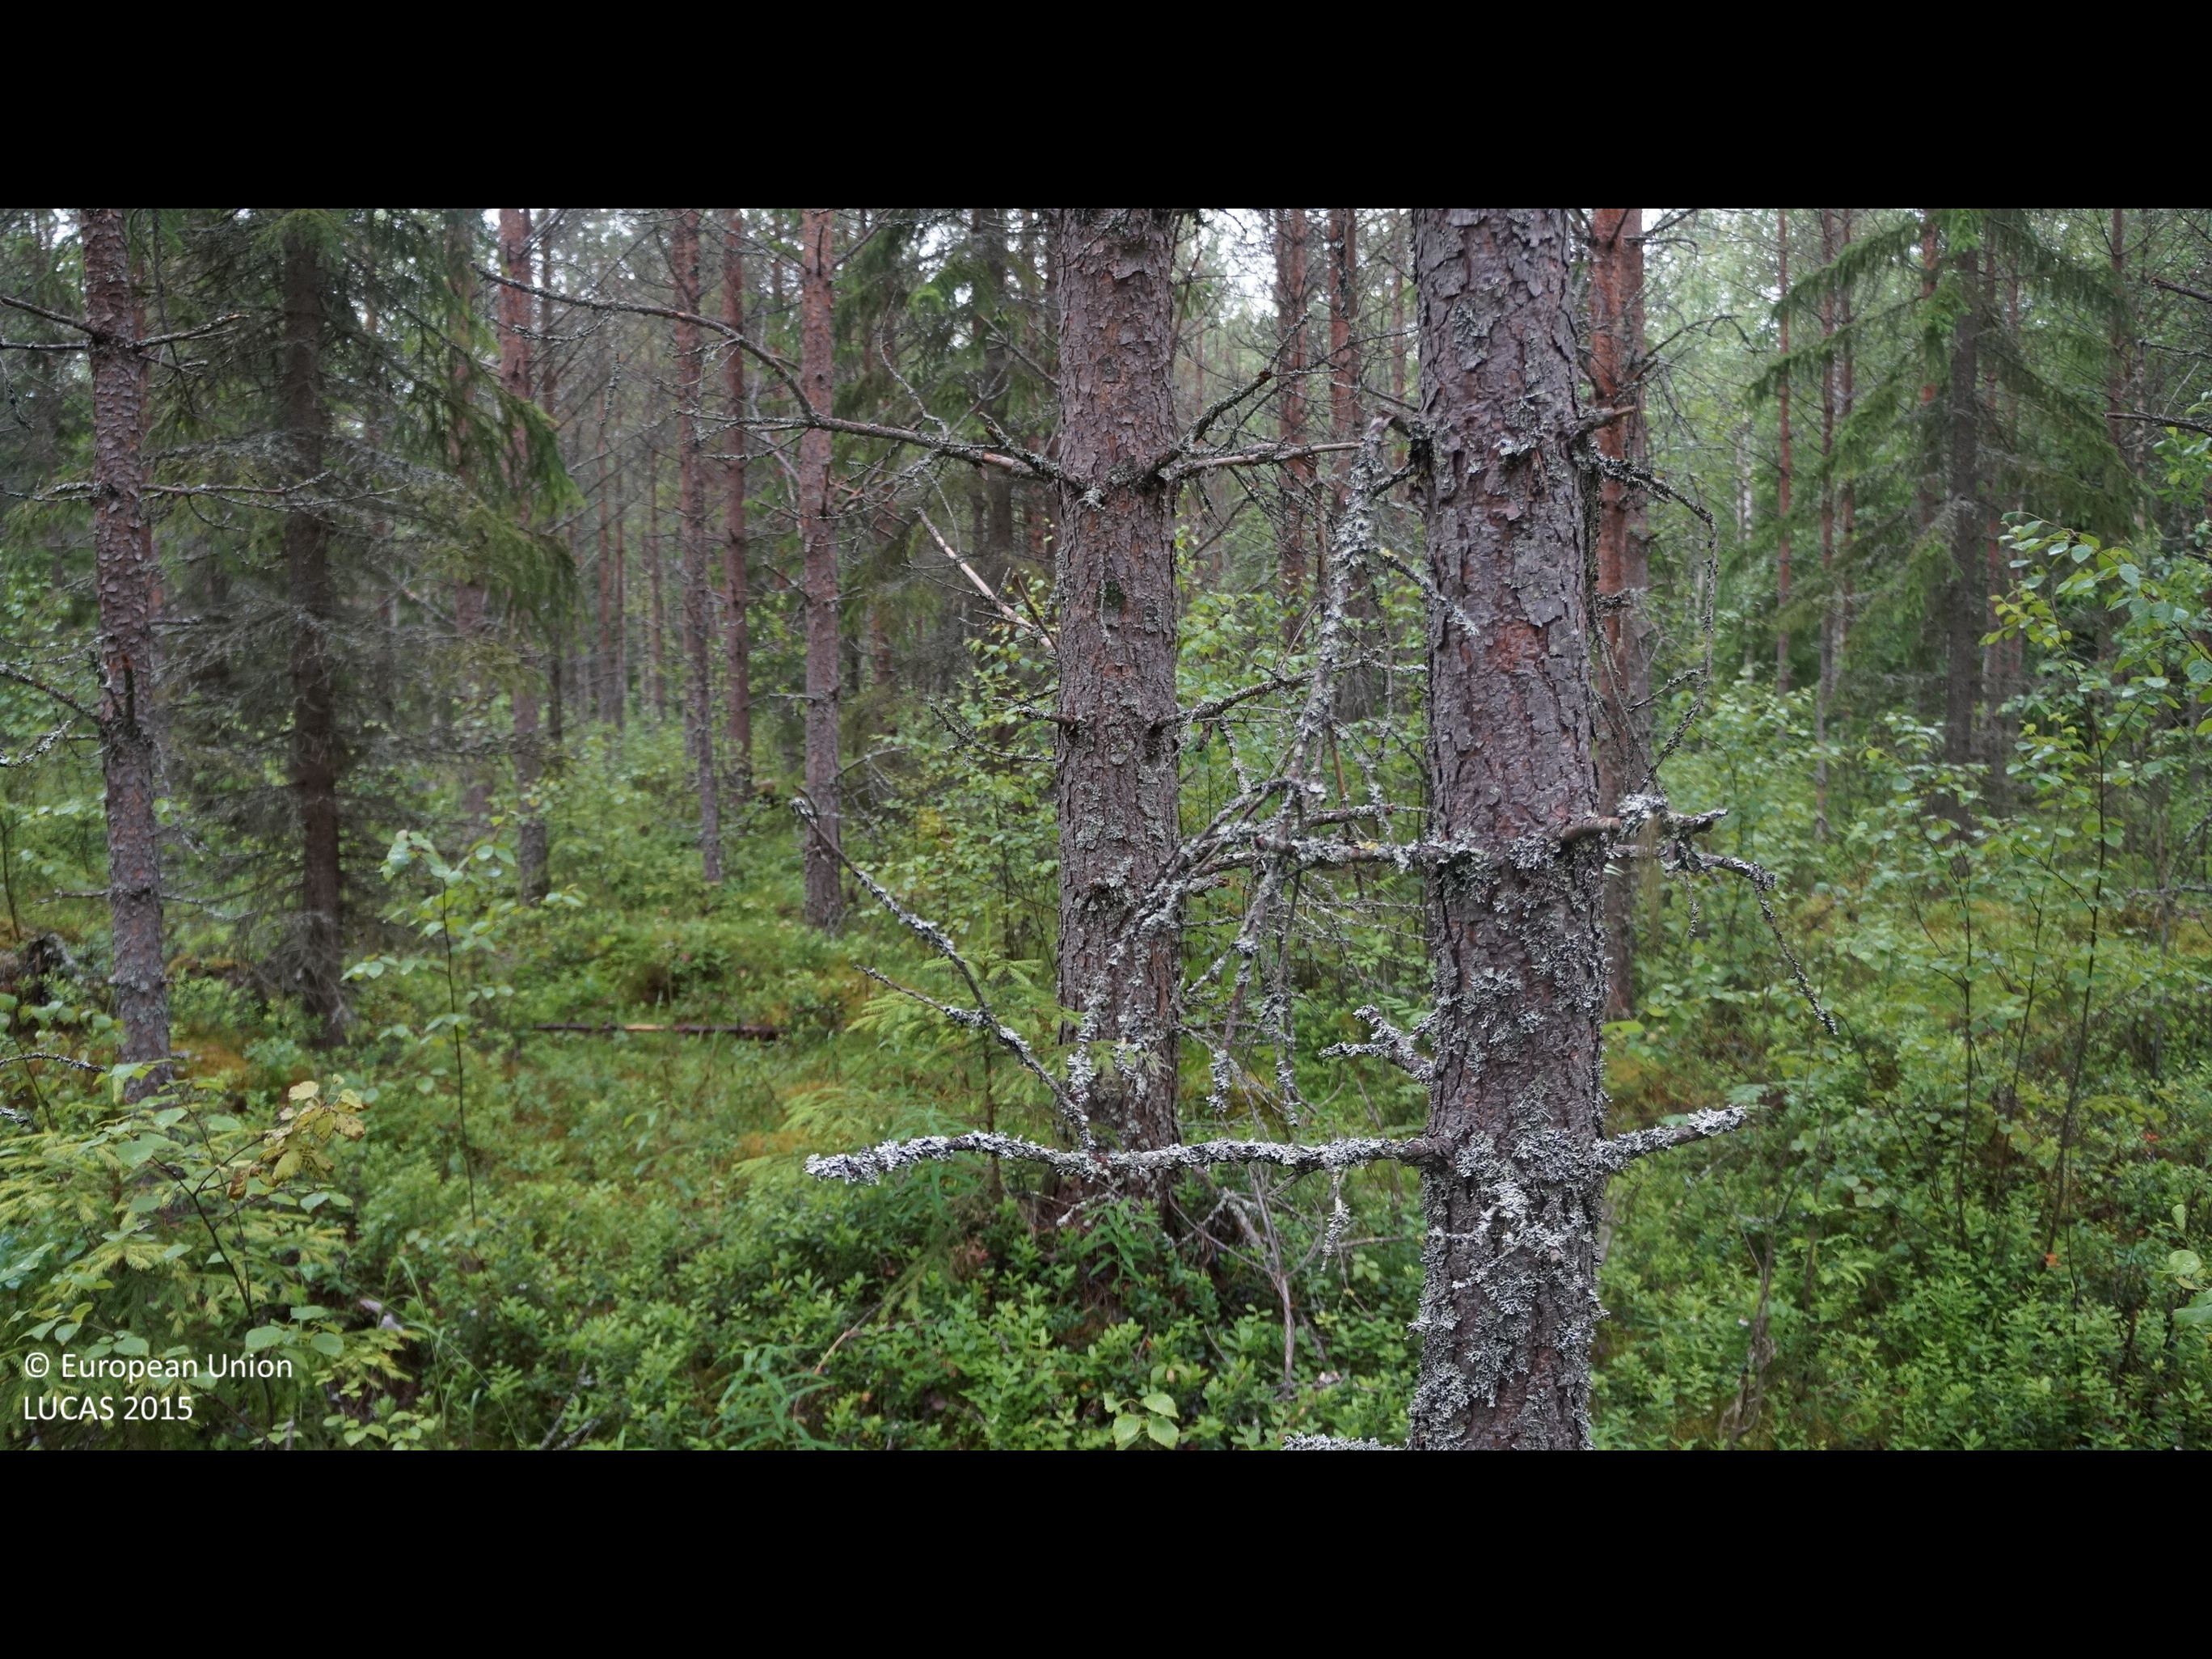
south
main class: Woodland
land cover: Pine dominated coniferous woodland
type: boreal forest
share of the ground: 50 - 75 %
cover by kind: coniferous forest trees 60 %, shrubs 30 %, broadleaved forest trees 5 %, lichens and mosses 5 %
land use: Forestry
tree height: > 5 m
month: July
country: FI
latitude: 64.4366
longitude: 24.8020
